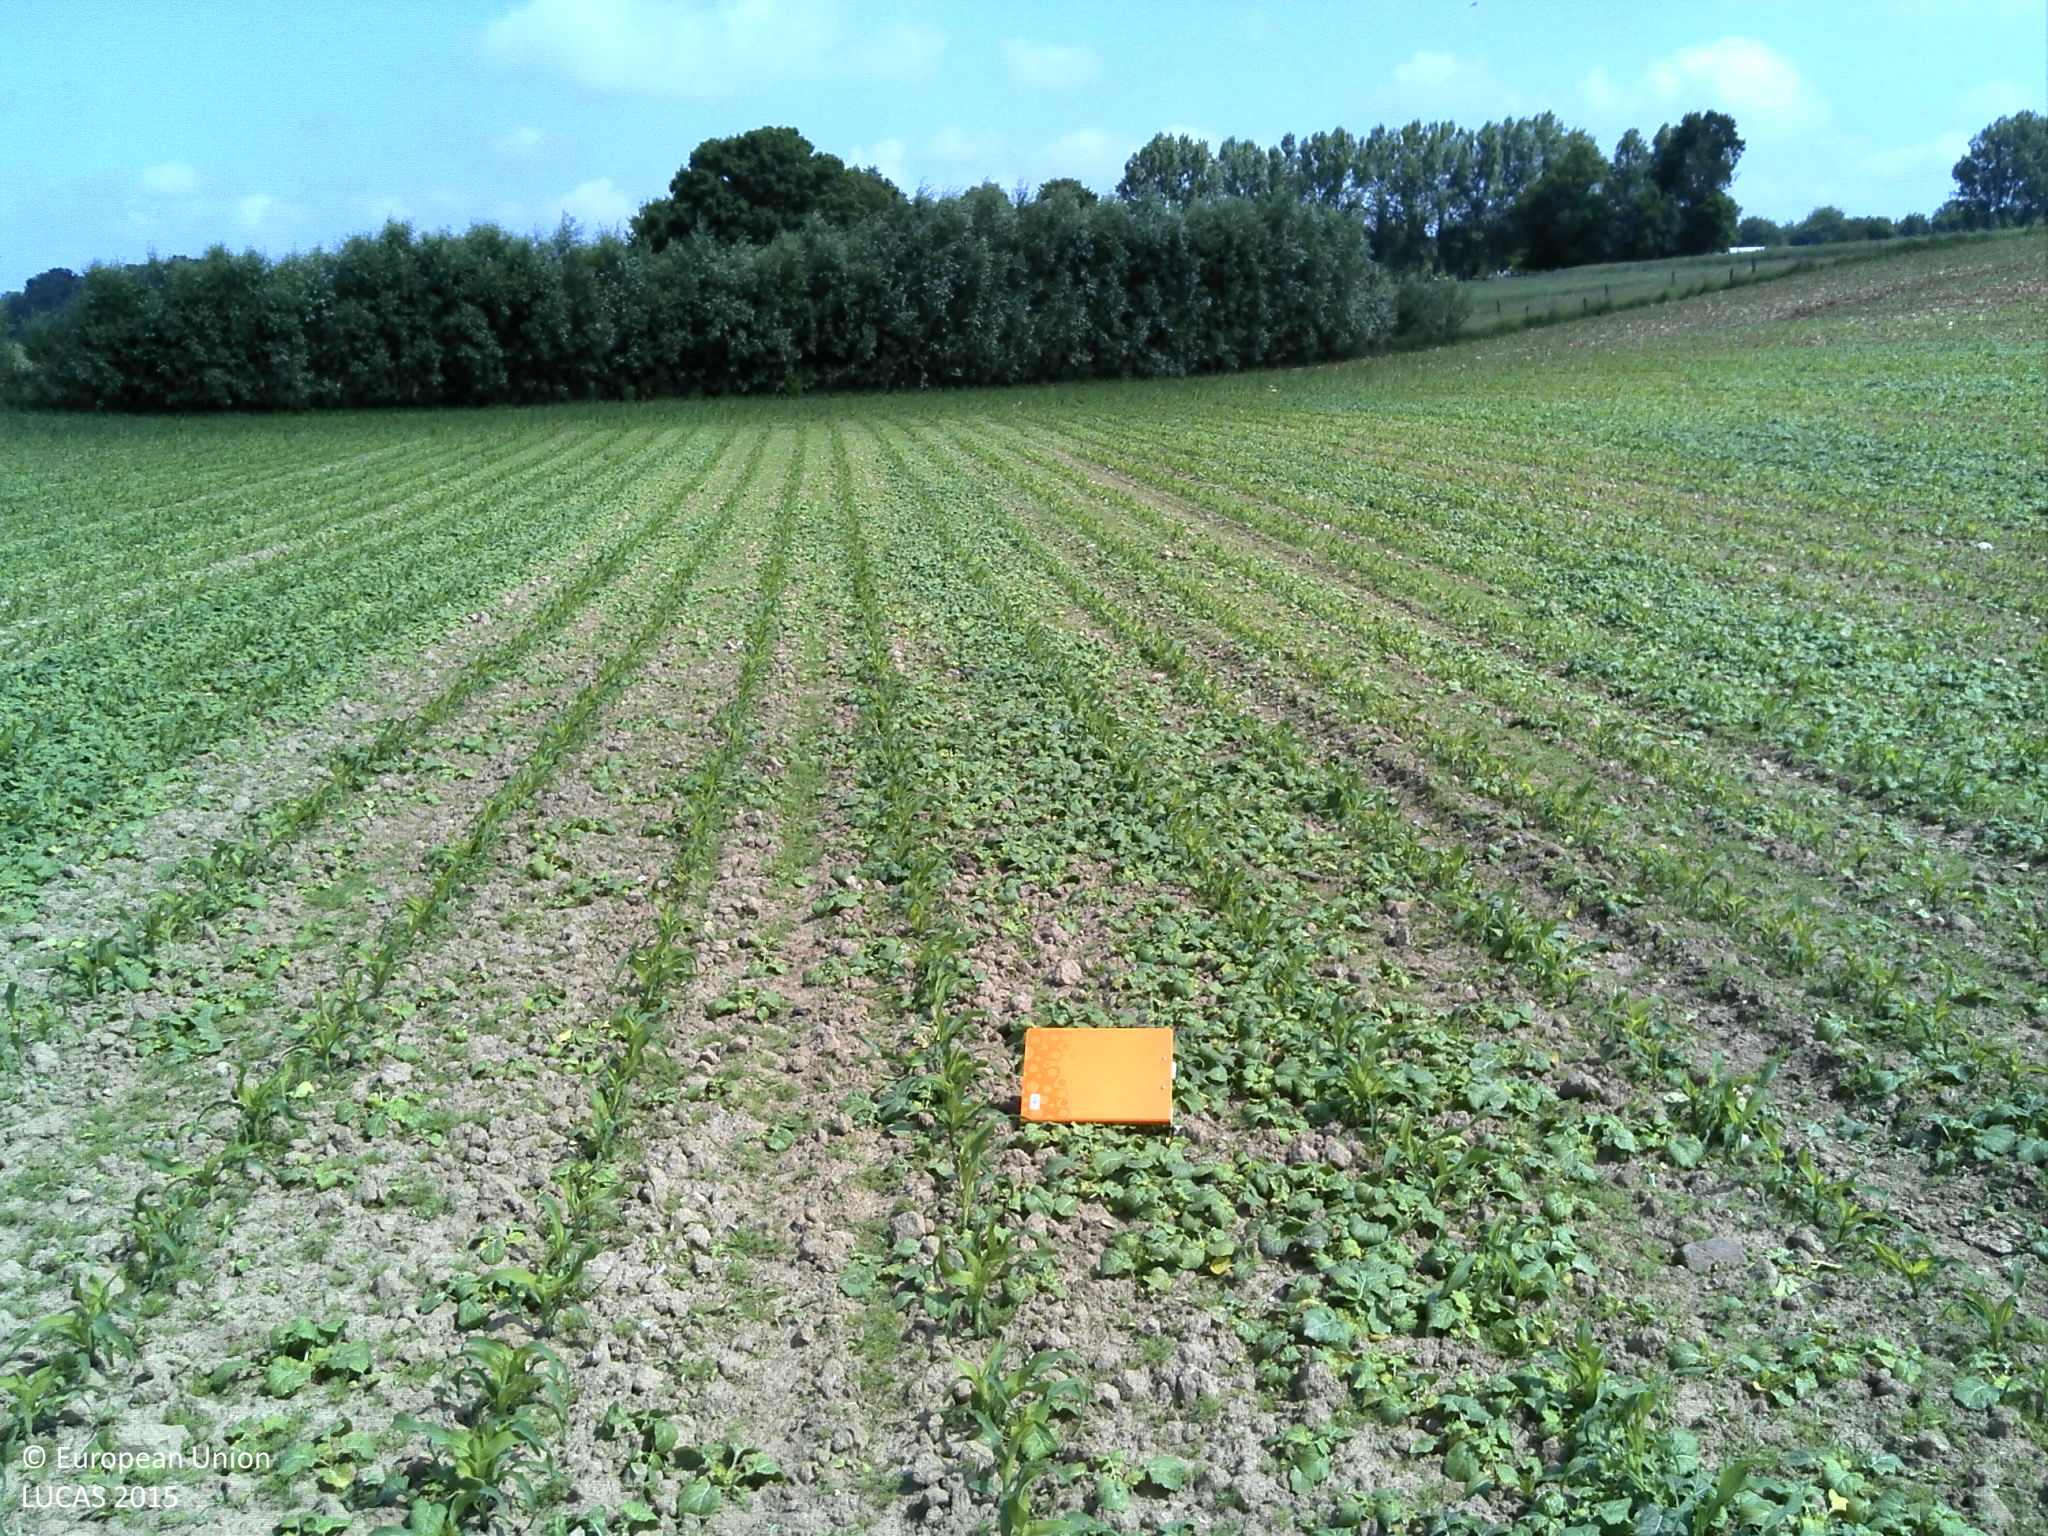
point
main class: Cropland
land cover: Maize
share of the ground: 10 - 25 %
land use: Agriculture (excluding fallow land and kitchen gardens)
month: June
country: FR
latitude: 49.5431
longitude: 0.6181
